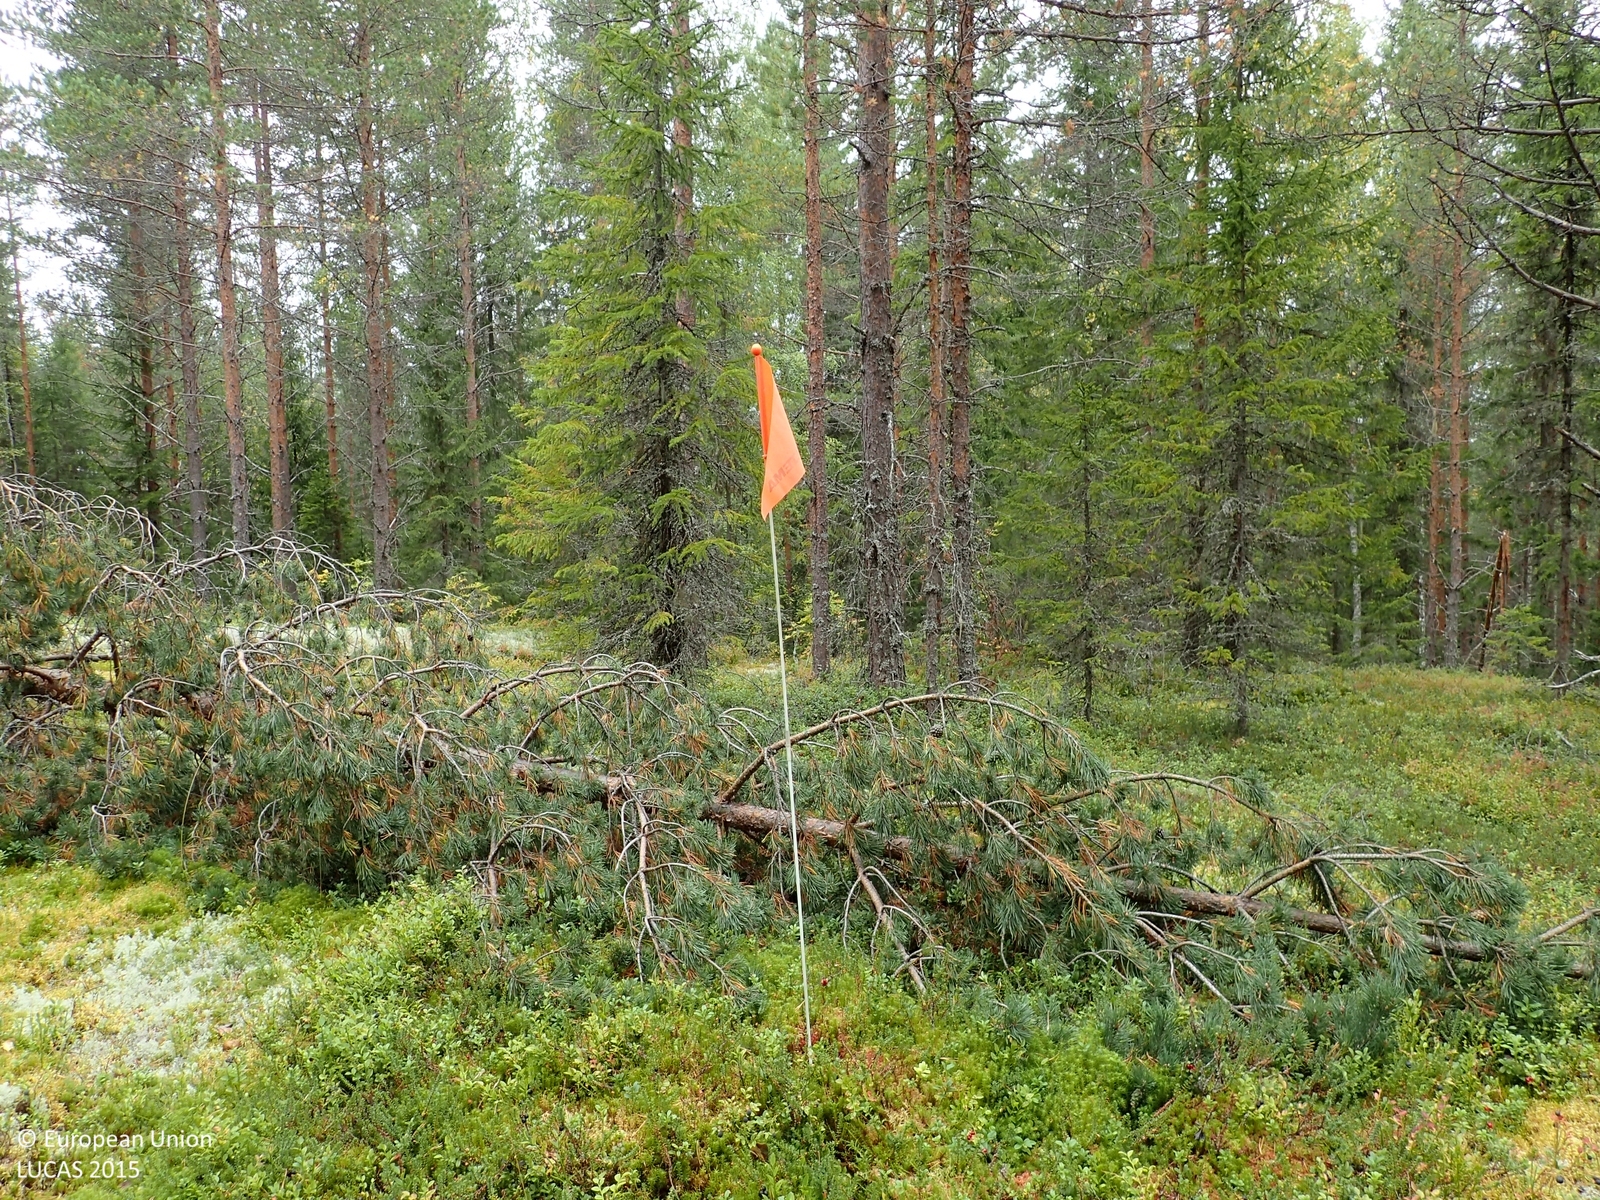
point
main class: Woodland
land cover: Other coniferous woodland
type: boreal forest
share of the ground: 50 - 75 %
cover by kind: coniferous forest trees 60 %, shrubs 25 %, broadleaved forest trees 10 %, lichens and mosses 5 %
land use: Forestry
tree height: > 5 m
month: September
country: FI
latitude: 62.9011
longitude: 25.7573
